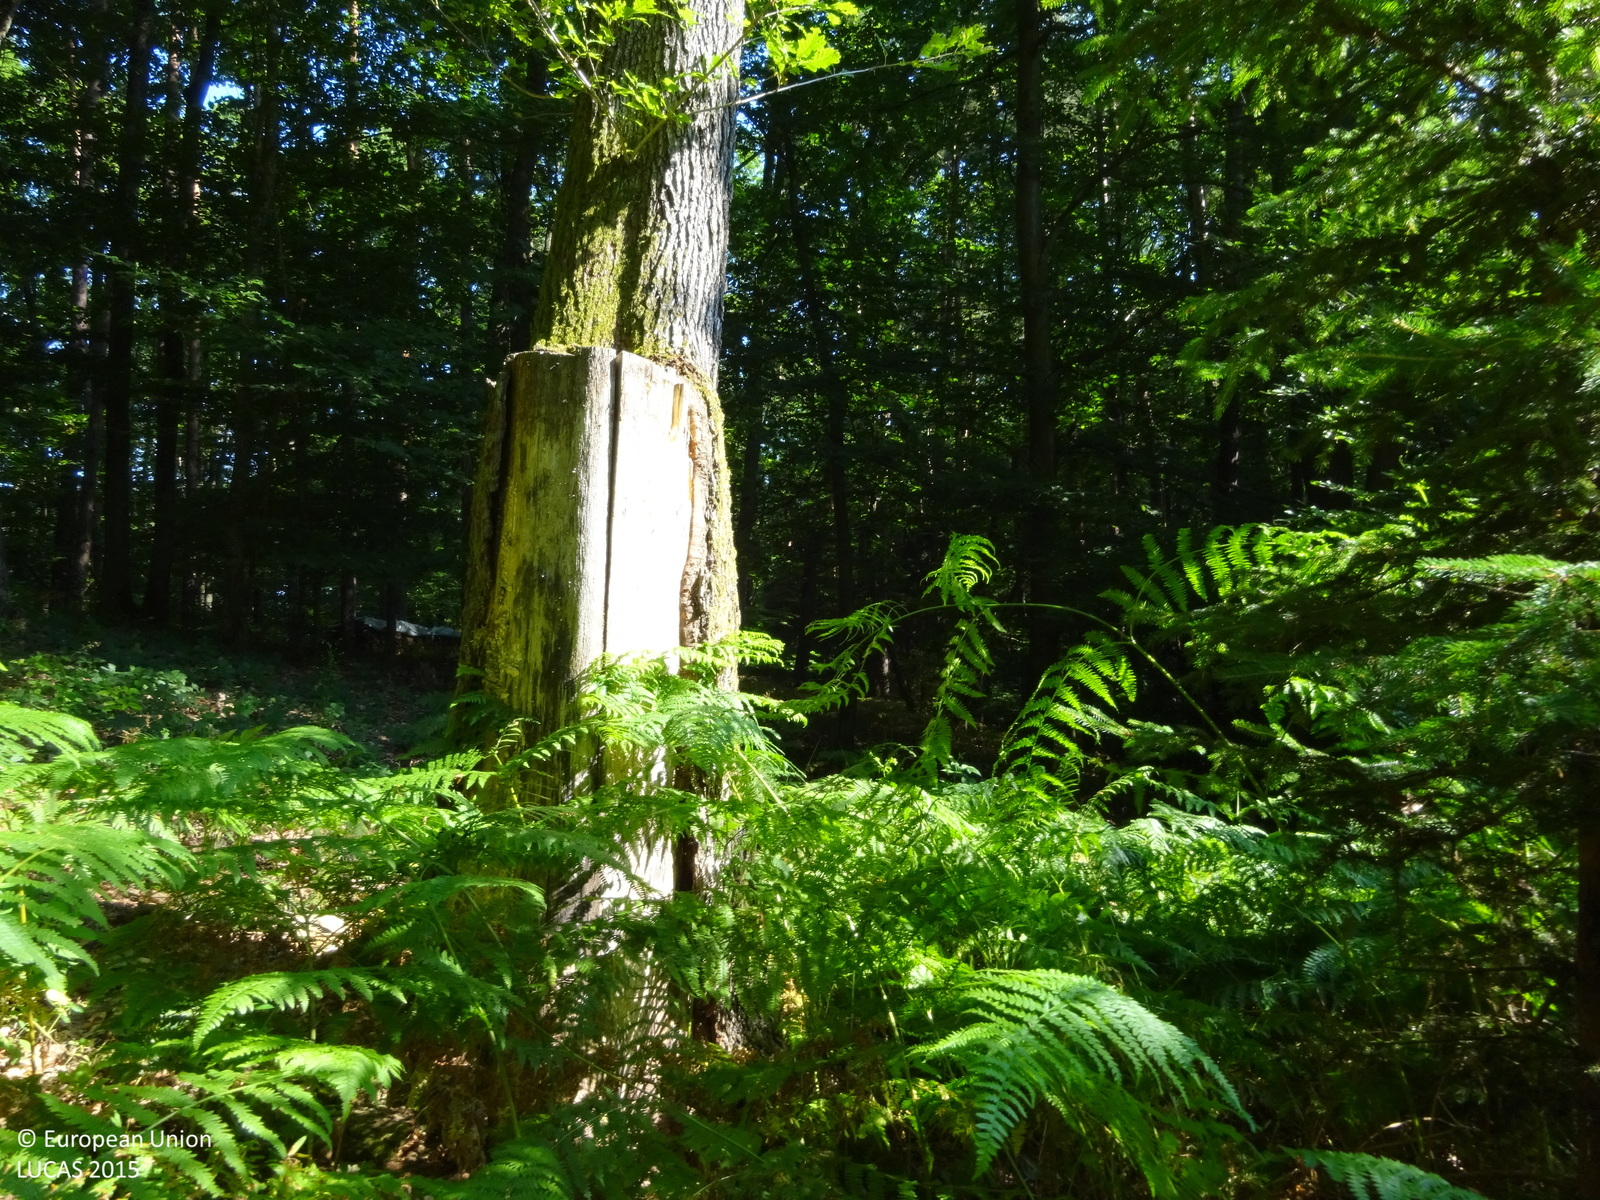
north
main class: Woodland
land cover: Spruce dominated mixed woodland
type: mountainous beech forest
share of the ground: > 75 %
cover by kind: broadleaved forest trees 70 %, coniferous forest trees 25 %, herbaceous plants 5 %
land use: Forestry
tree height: > 5 m
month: July
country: AT
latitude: 46.9230
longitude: 16.0023
